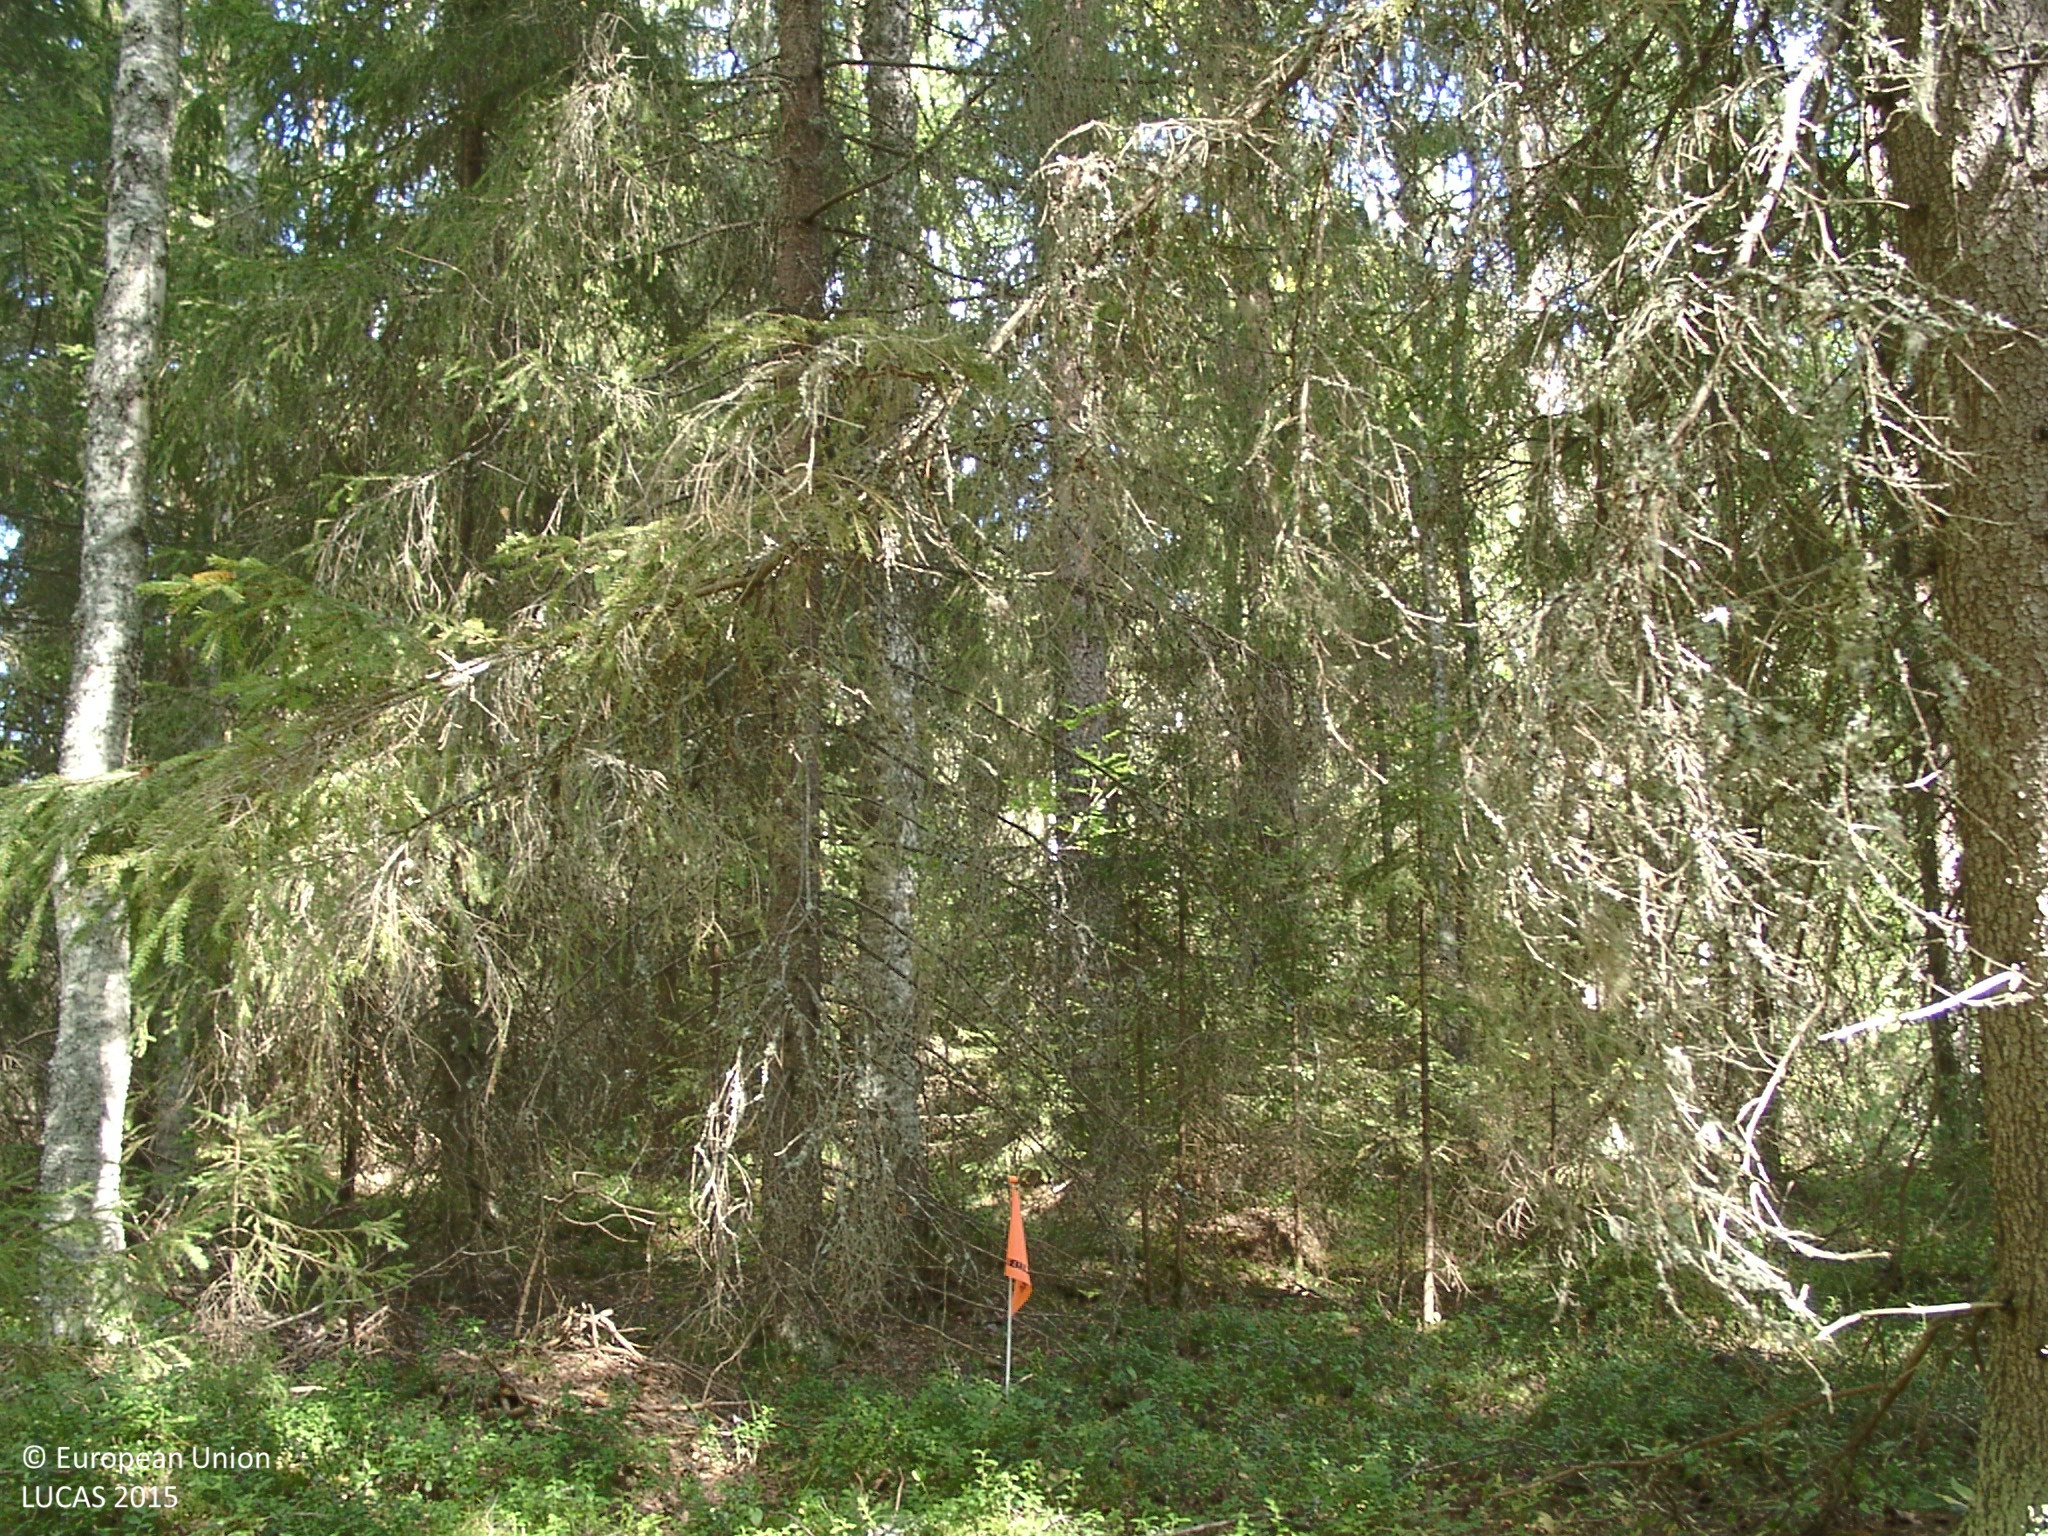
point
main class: Woodland
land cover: Other mixed woodland
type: boreal forest
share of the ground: > 75 %
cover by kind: coniferous forest trees 60 %, broadleaved forest trees 20 %, shrubs 10 %, lichens and mosses 10 %
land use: Forestry
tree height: > 5 m
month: August
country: FI
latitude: 61.8034
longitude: 24.9607
